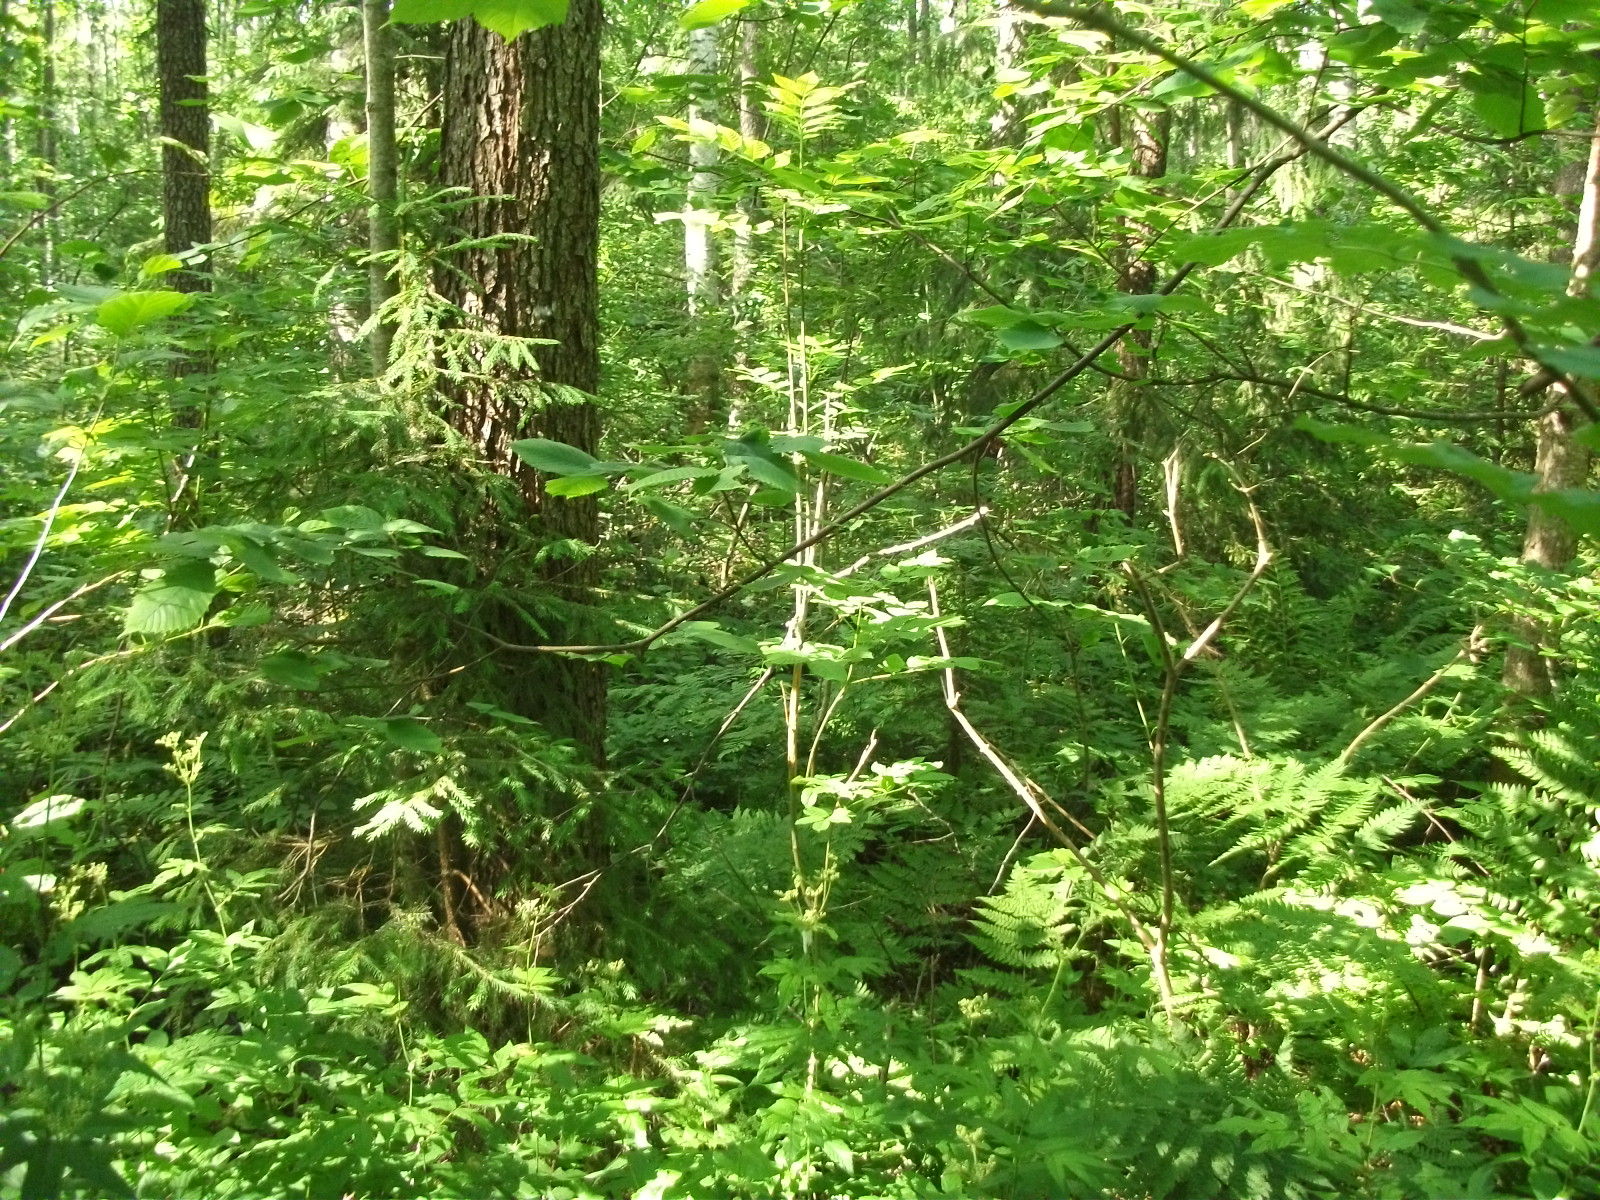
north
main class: Woodland
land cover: Broadleaved woodland
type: non-riverine alder, birch or aspen forest
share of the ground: > 75 %
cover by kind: broadleaved forest trees 85 %, coniferous forest trees 5 %, shrubs 5 %, herbaceous plants 5 %
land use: Forestry
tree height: > 5 m
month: June
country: LV
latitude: 57.0108
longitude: 26.7351
